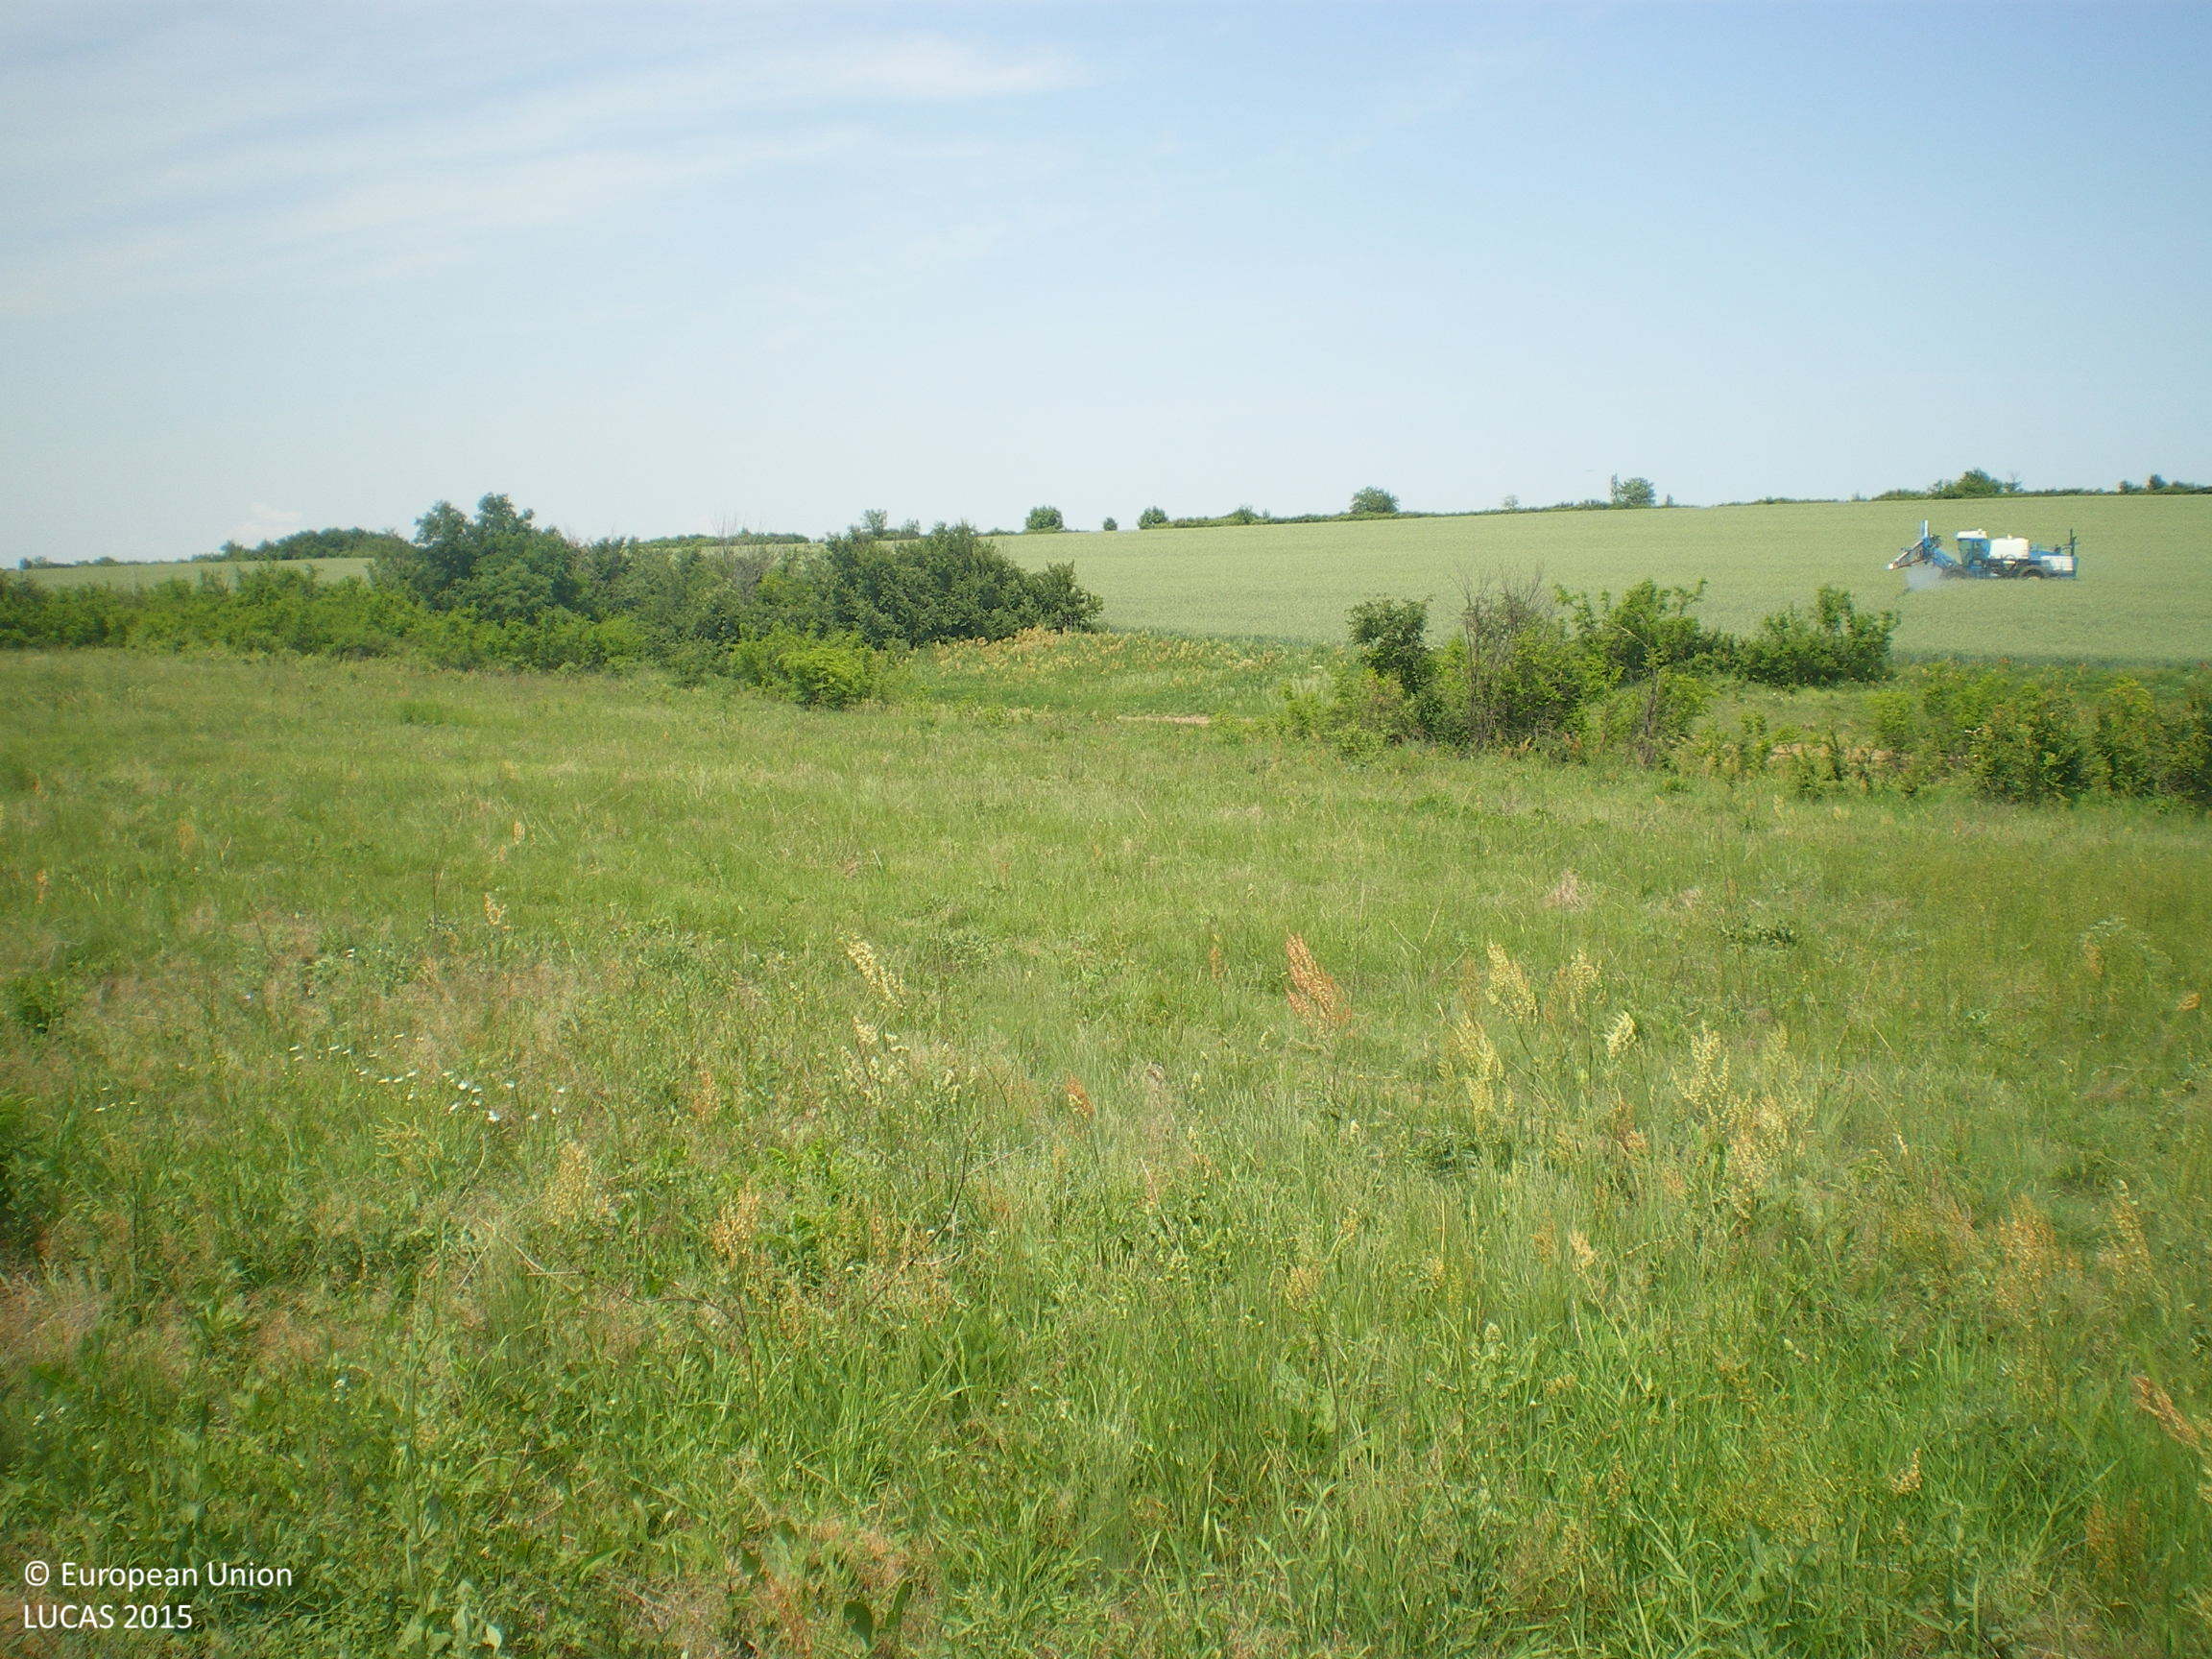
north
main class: Grassland
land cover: Spontaneously vegetated surfaces
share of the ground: > 75 %
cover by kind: herbaceous plants 100 %
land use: Semi-natural and natural areas not in use
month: May
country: BG
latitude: 42.1198
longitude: 25.3389
